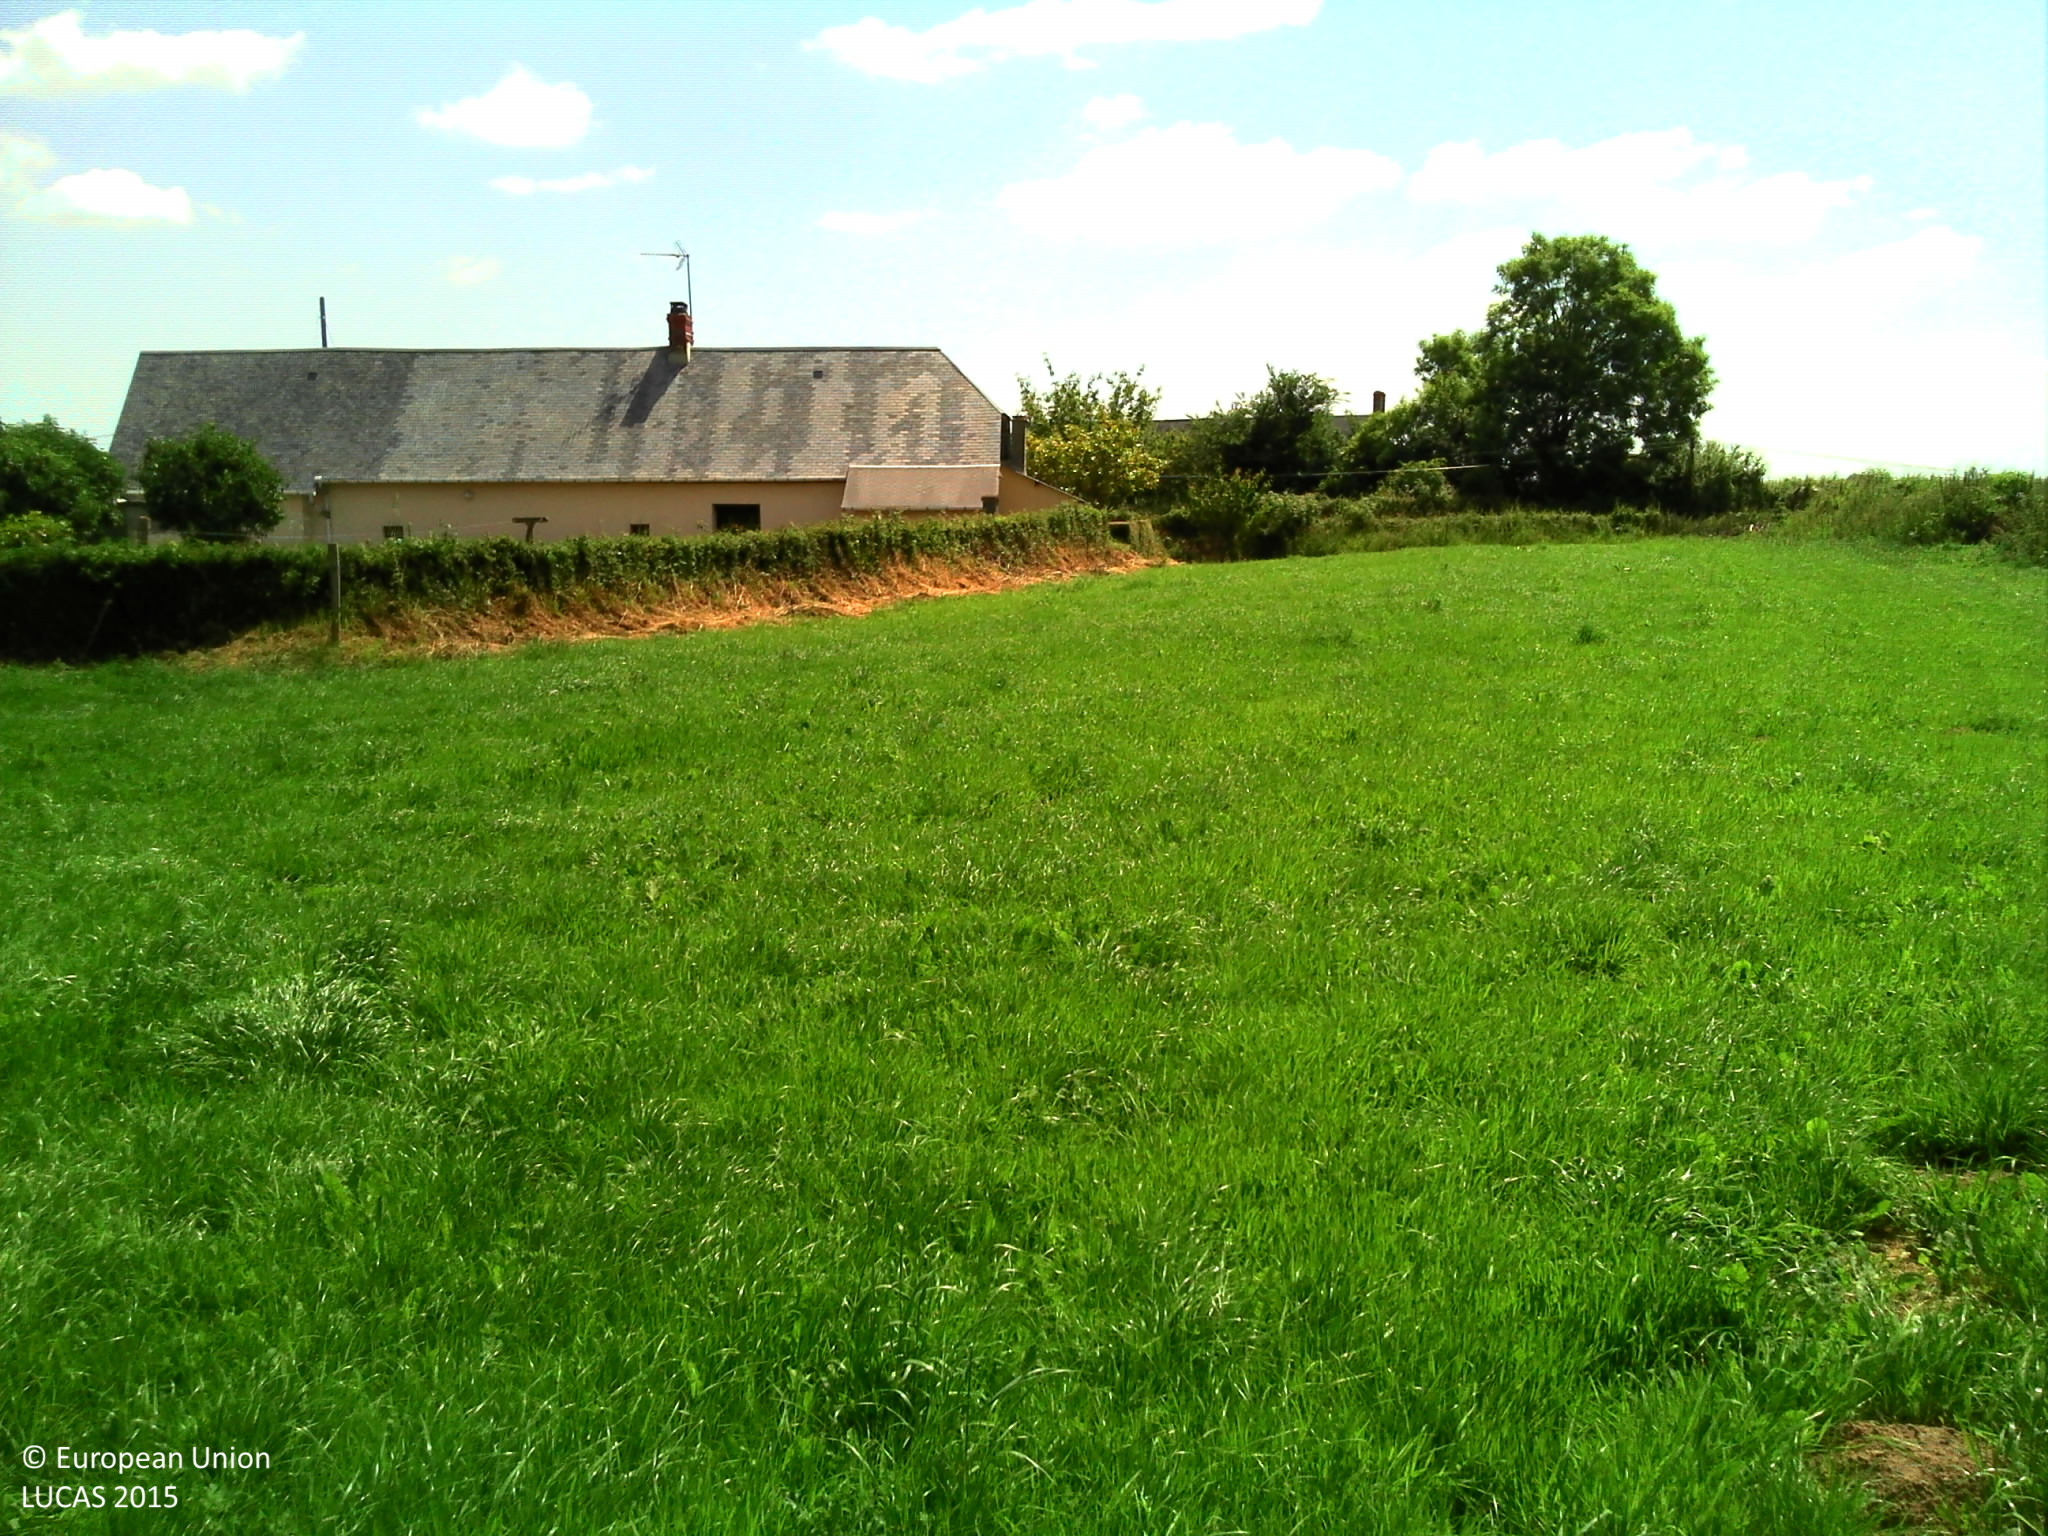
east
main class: Grassland
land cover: Grassland without tree/shrub cover
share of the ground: > 75 %
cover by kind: herbaceous plants 100 %
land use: Agriculture (excluding fallow land and kitchen gardens)
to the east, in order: Grassland without tree/shrub cover; Artificial constructions in urban areas; Grassland without tree/shrub cover; Fences; Grassland without tree/shrub cover; Electric lines; Grassland without tree/shrub cover; Artificial constructions in urban areas; Broadleaved woodland; Maize; Ditches and canals; Grass margins
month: June
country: FR
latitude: 49.2639
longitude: -1.4123
